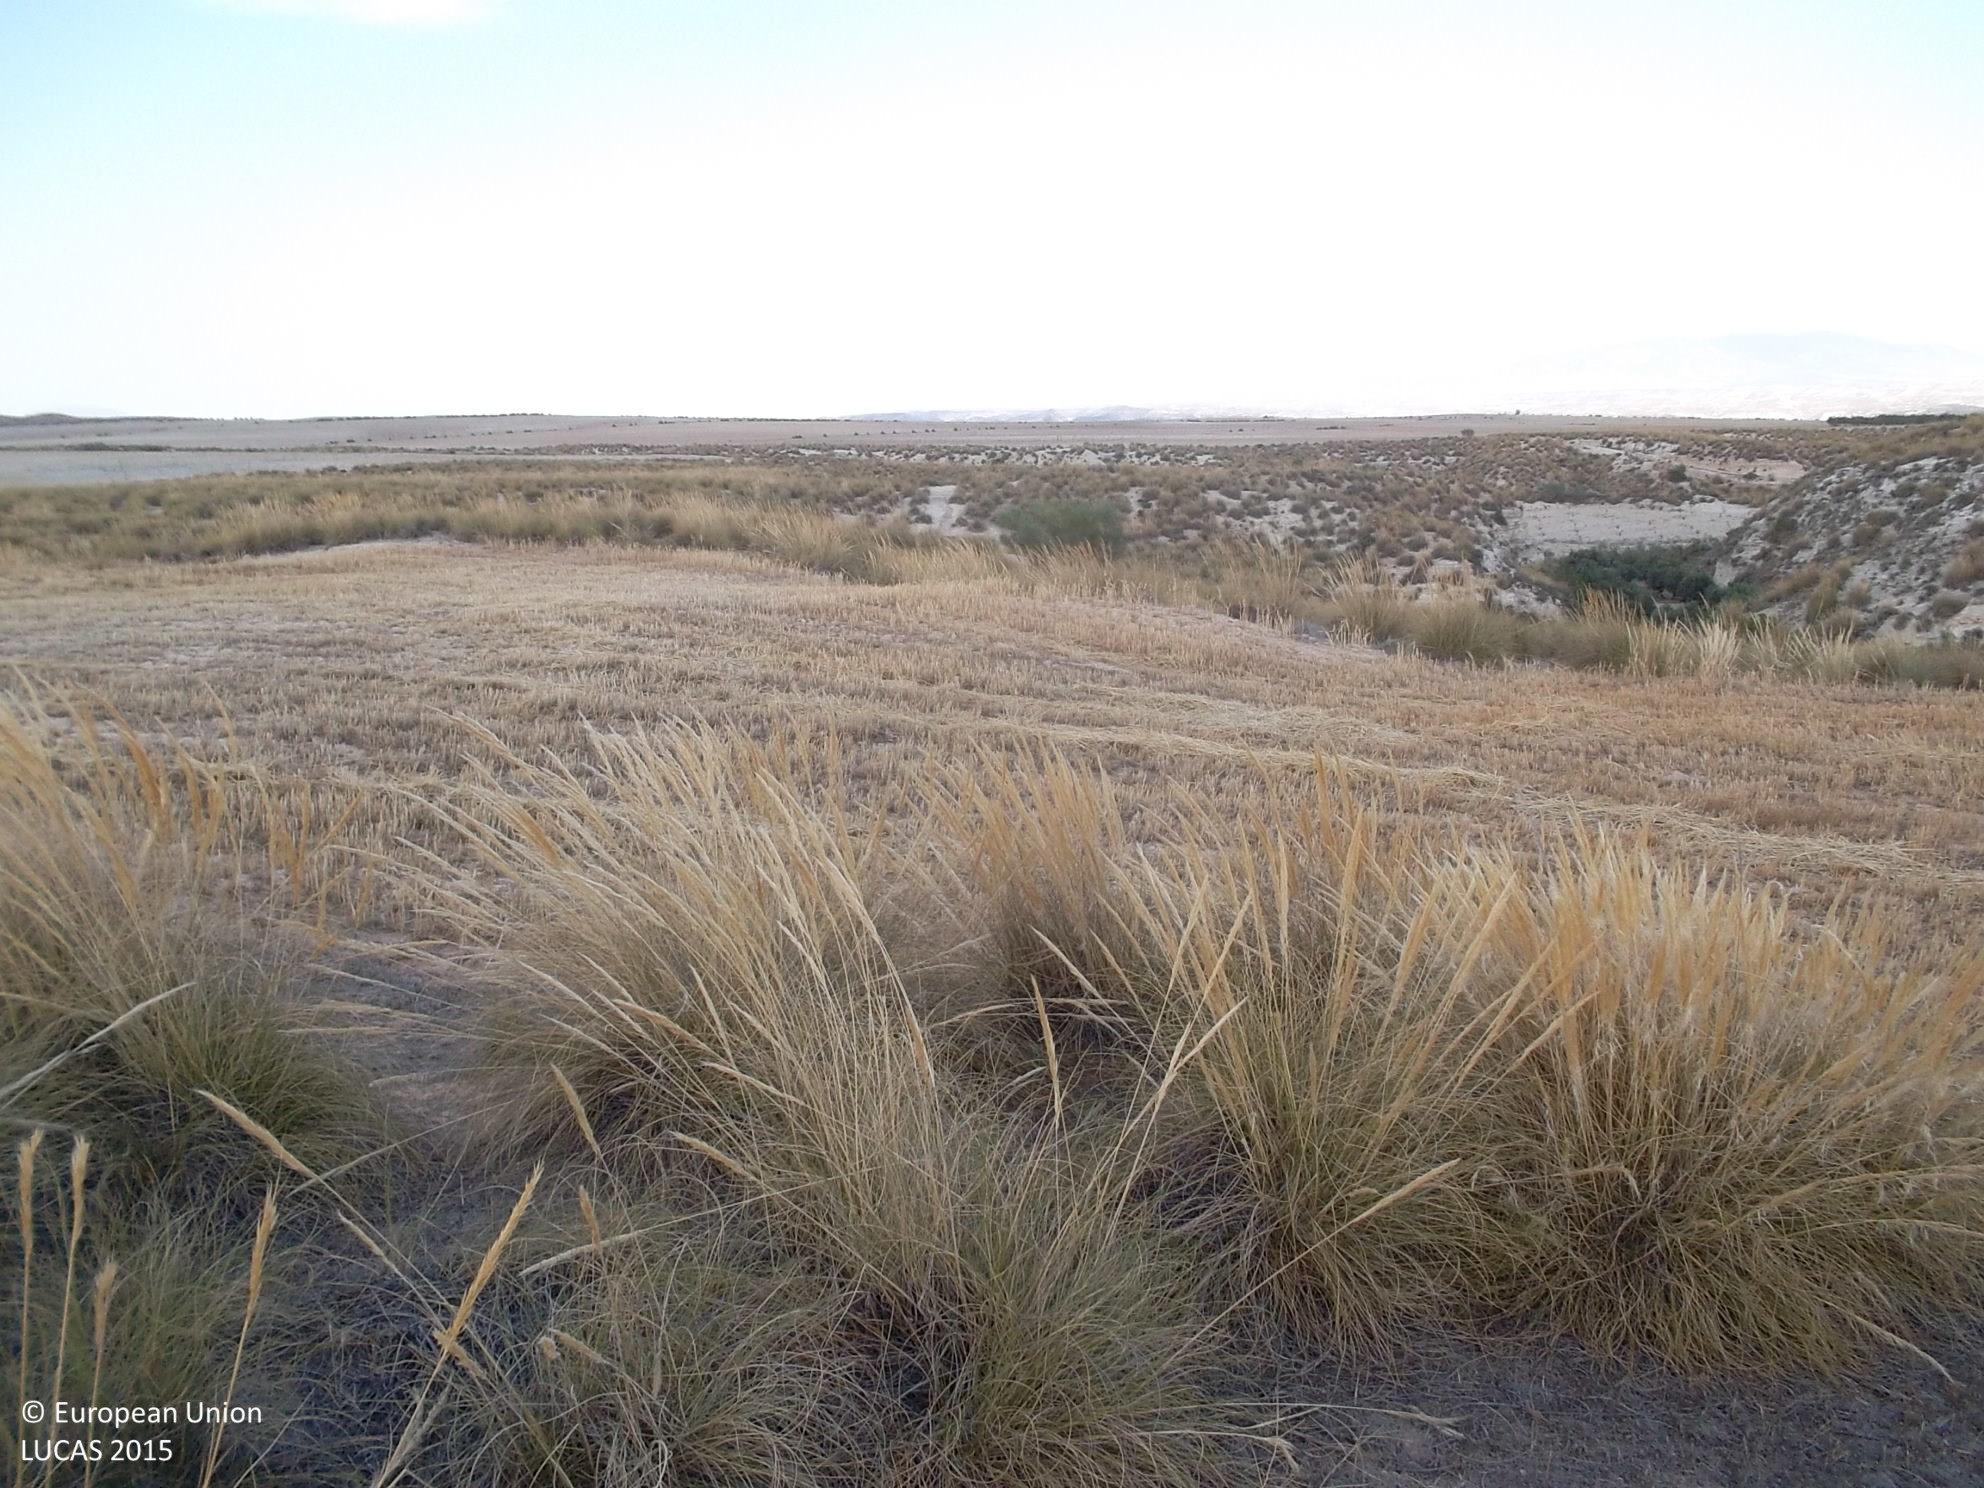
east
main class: Grassland
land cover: Grassland without tree/shrub cover
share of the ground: 50 - 75 %
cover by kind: herbaceous plants 65 %, unconsolidated bare surface 35 %
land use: Agriculture (excluding fallow land and kitchen gardens)
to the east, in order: Grassland without tree/shrub cover; Durum wheat; Shrubland without tree cover; Olive groves; Shrubland without tree cover; Ditches and canals; Shrubland without tree cover; Nuts trees
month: July
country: ES
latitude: 37.6776
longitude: -2.7225
